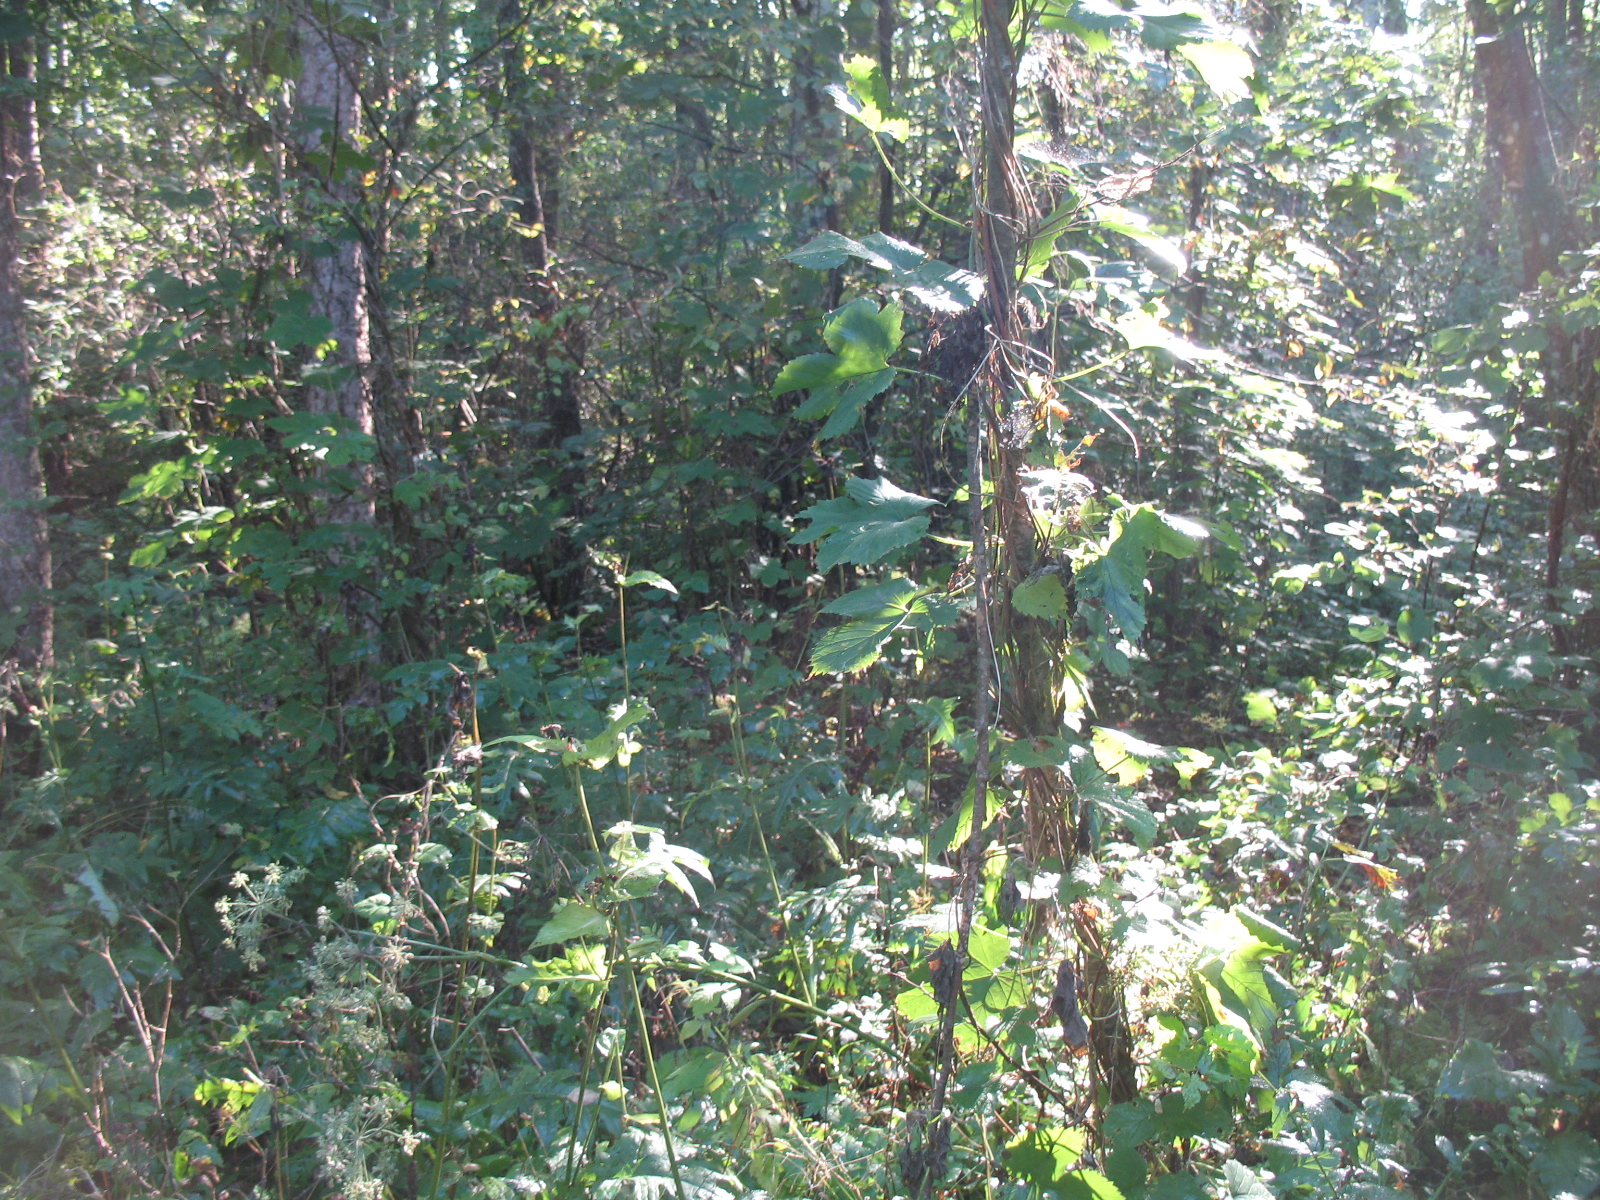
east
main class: Woodland
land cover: Broadleaved woodland
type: non-riverine alder, birch or aspen forest
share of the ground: 50 - 75 %
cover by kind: broadleaved forest trees 55 %, herbaceous plants 40 %, shrubs 5 %
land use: Forestry
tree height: > 5 m
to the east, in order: Broadleaved woodland
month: September
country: LV
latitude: 56.1904
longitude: 25.5109
